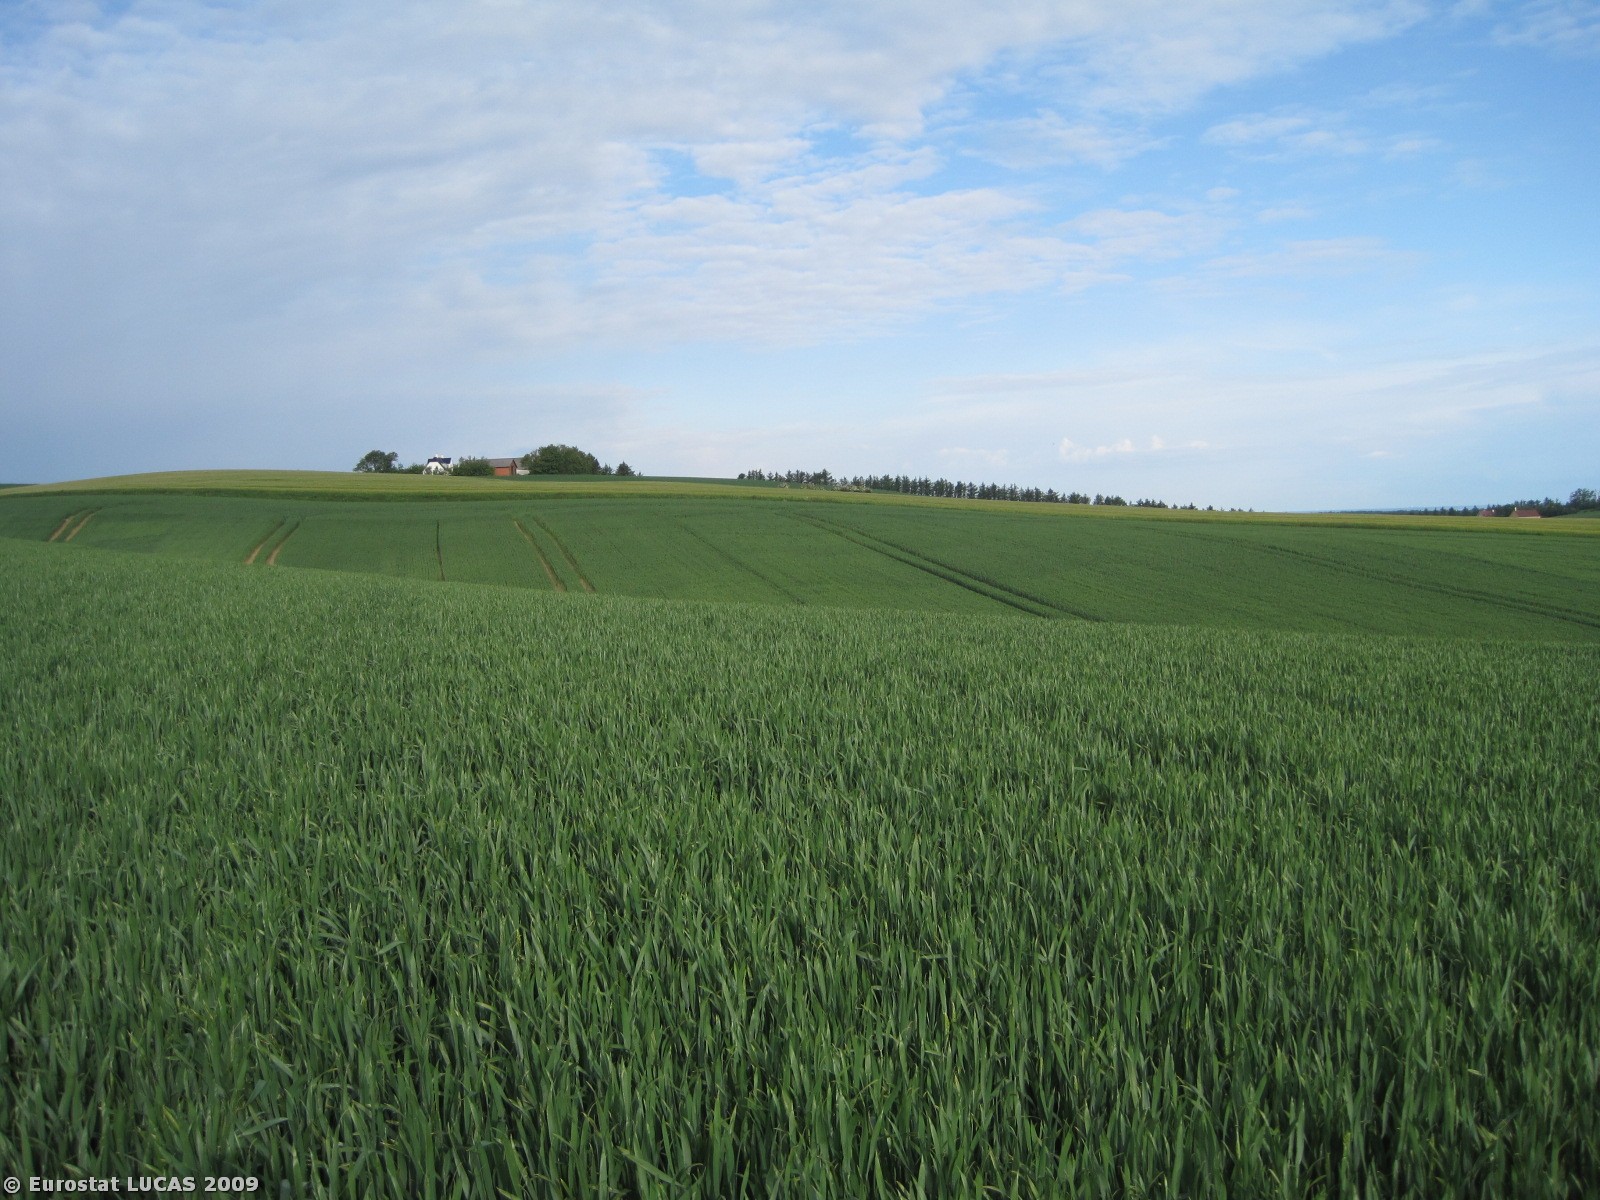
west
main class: Cropland
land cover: Common wheat
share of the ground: > 75 %
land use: Agriculture (excluding fallow land and kitchen gardens)
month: June
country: DK
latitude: 57.5361
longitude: 9.9833
